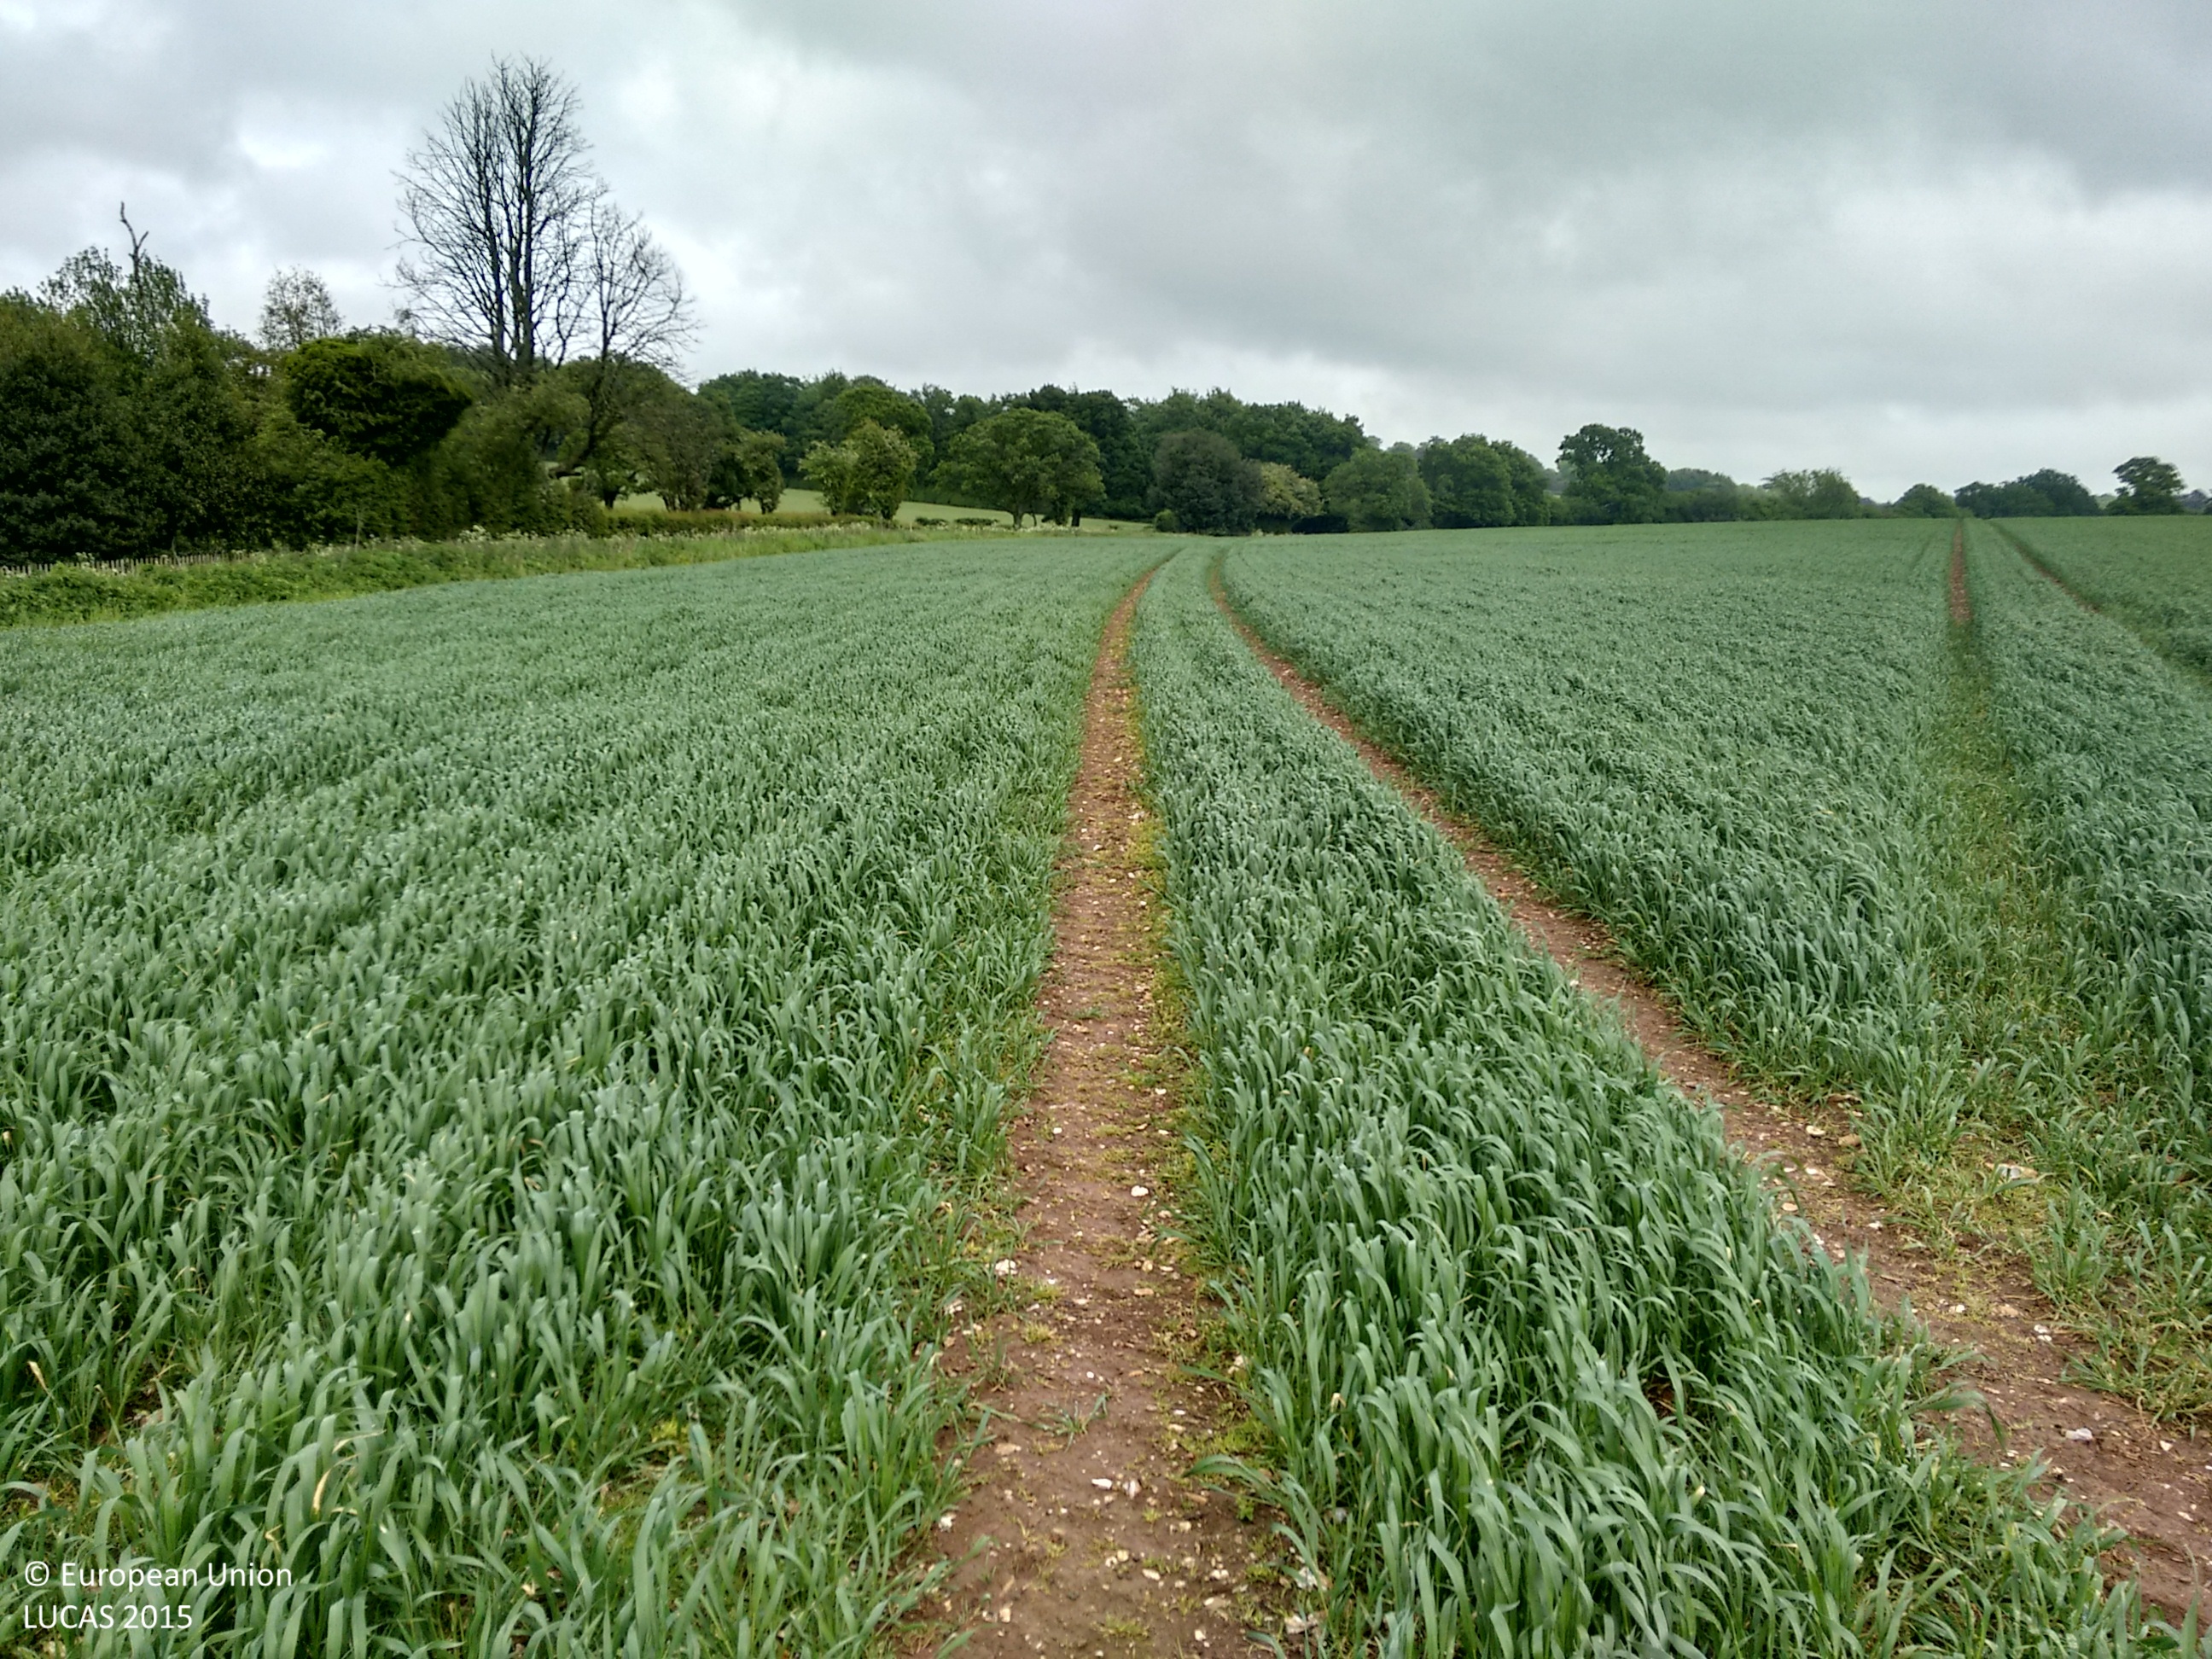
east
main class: Cropland
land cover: Common wheat
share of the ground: 50 - 75 %
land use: Agriculture (excluding fallow land and kitchen gardens)
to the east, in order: Common wheat; Shruby margins; Paved roads, cycling and walking lanes; Managed hedges; Fences; Grassland without tree/shrub cover; Fences; Shruby margins; Rape and turnip rape
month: June
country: GB
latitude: 51.0357
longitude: -1.1266
